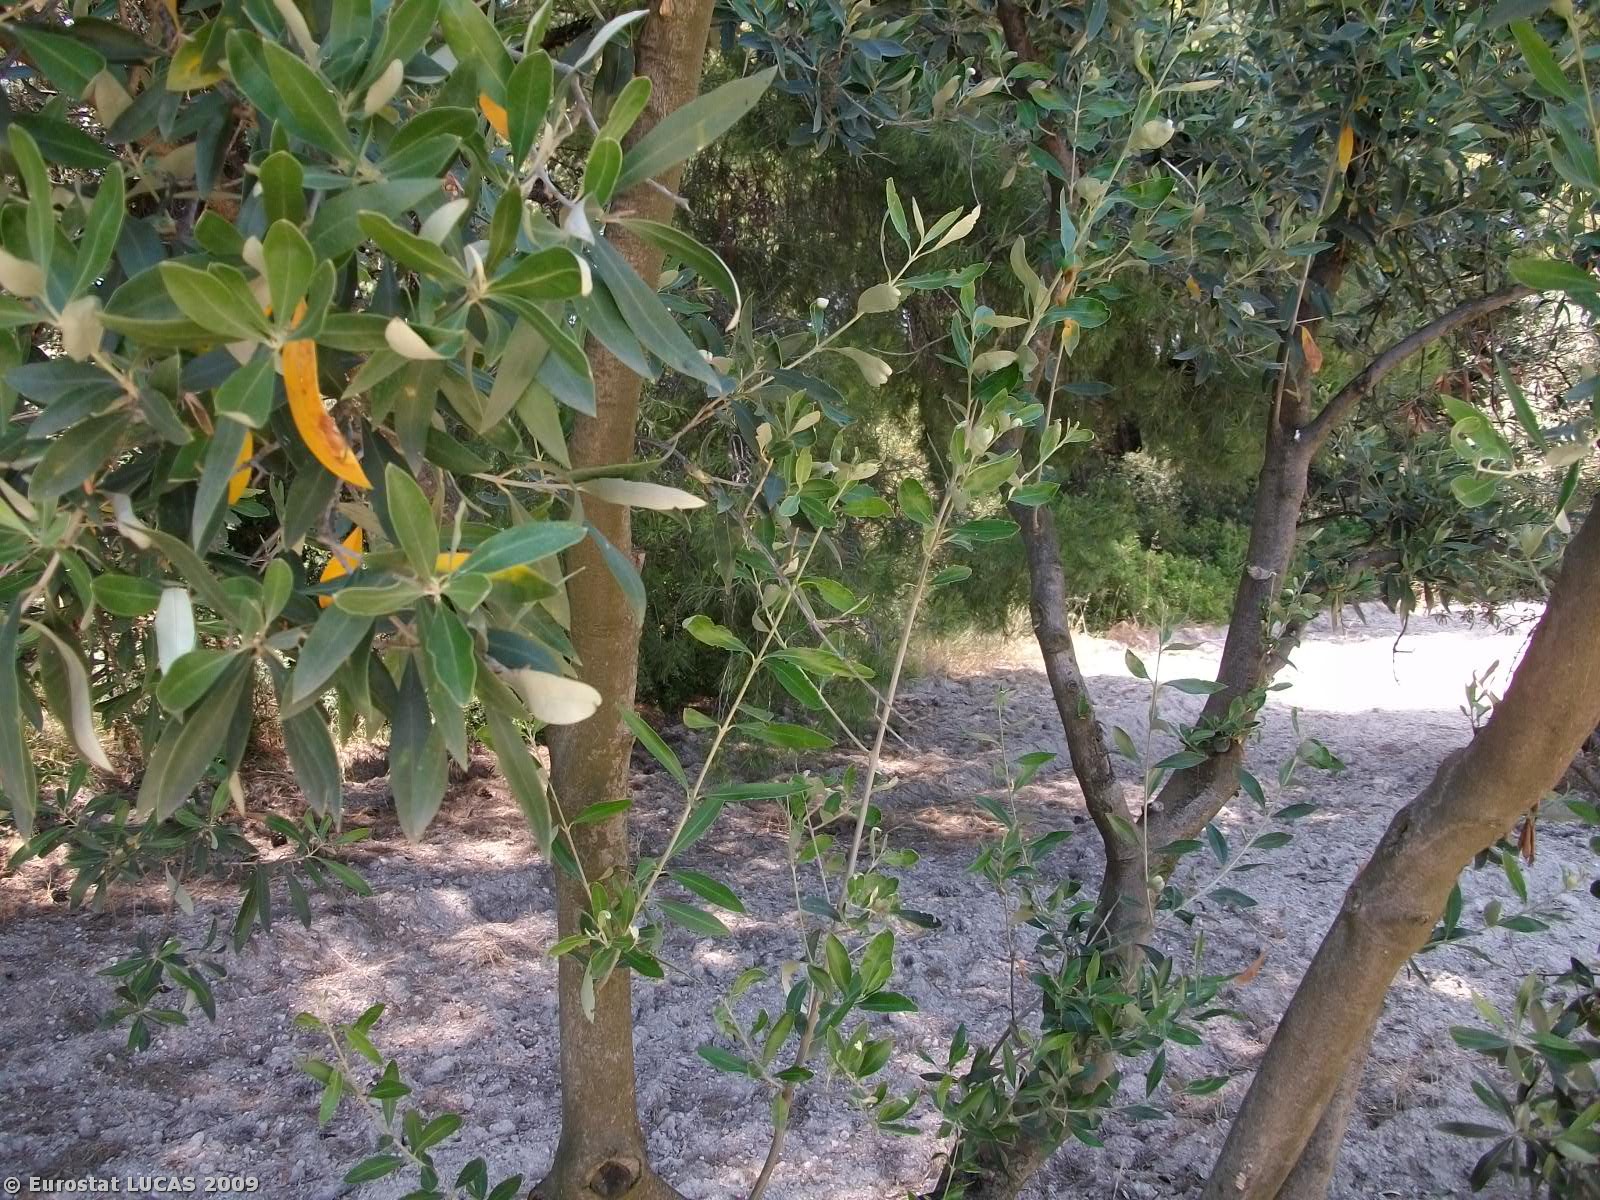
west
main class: Cropland
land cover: Olive groves
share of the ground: 25 - 50 %
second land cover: Bare land
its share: > 75 %
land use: Agriculture (excluding fallow land and kitchen gardens)
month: June
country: GR
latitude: 40.0811
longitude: 23.3626
